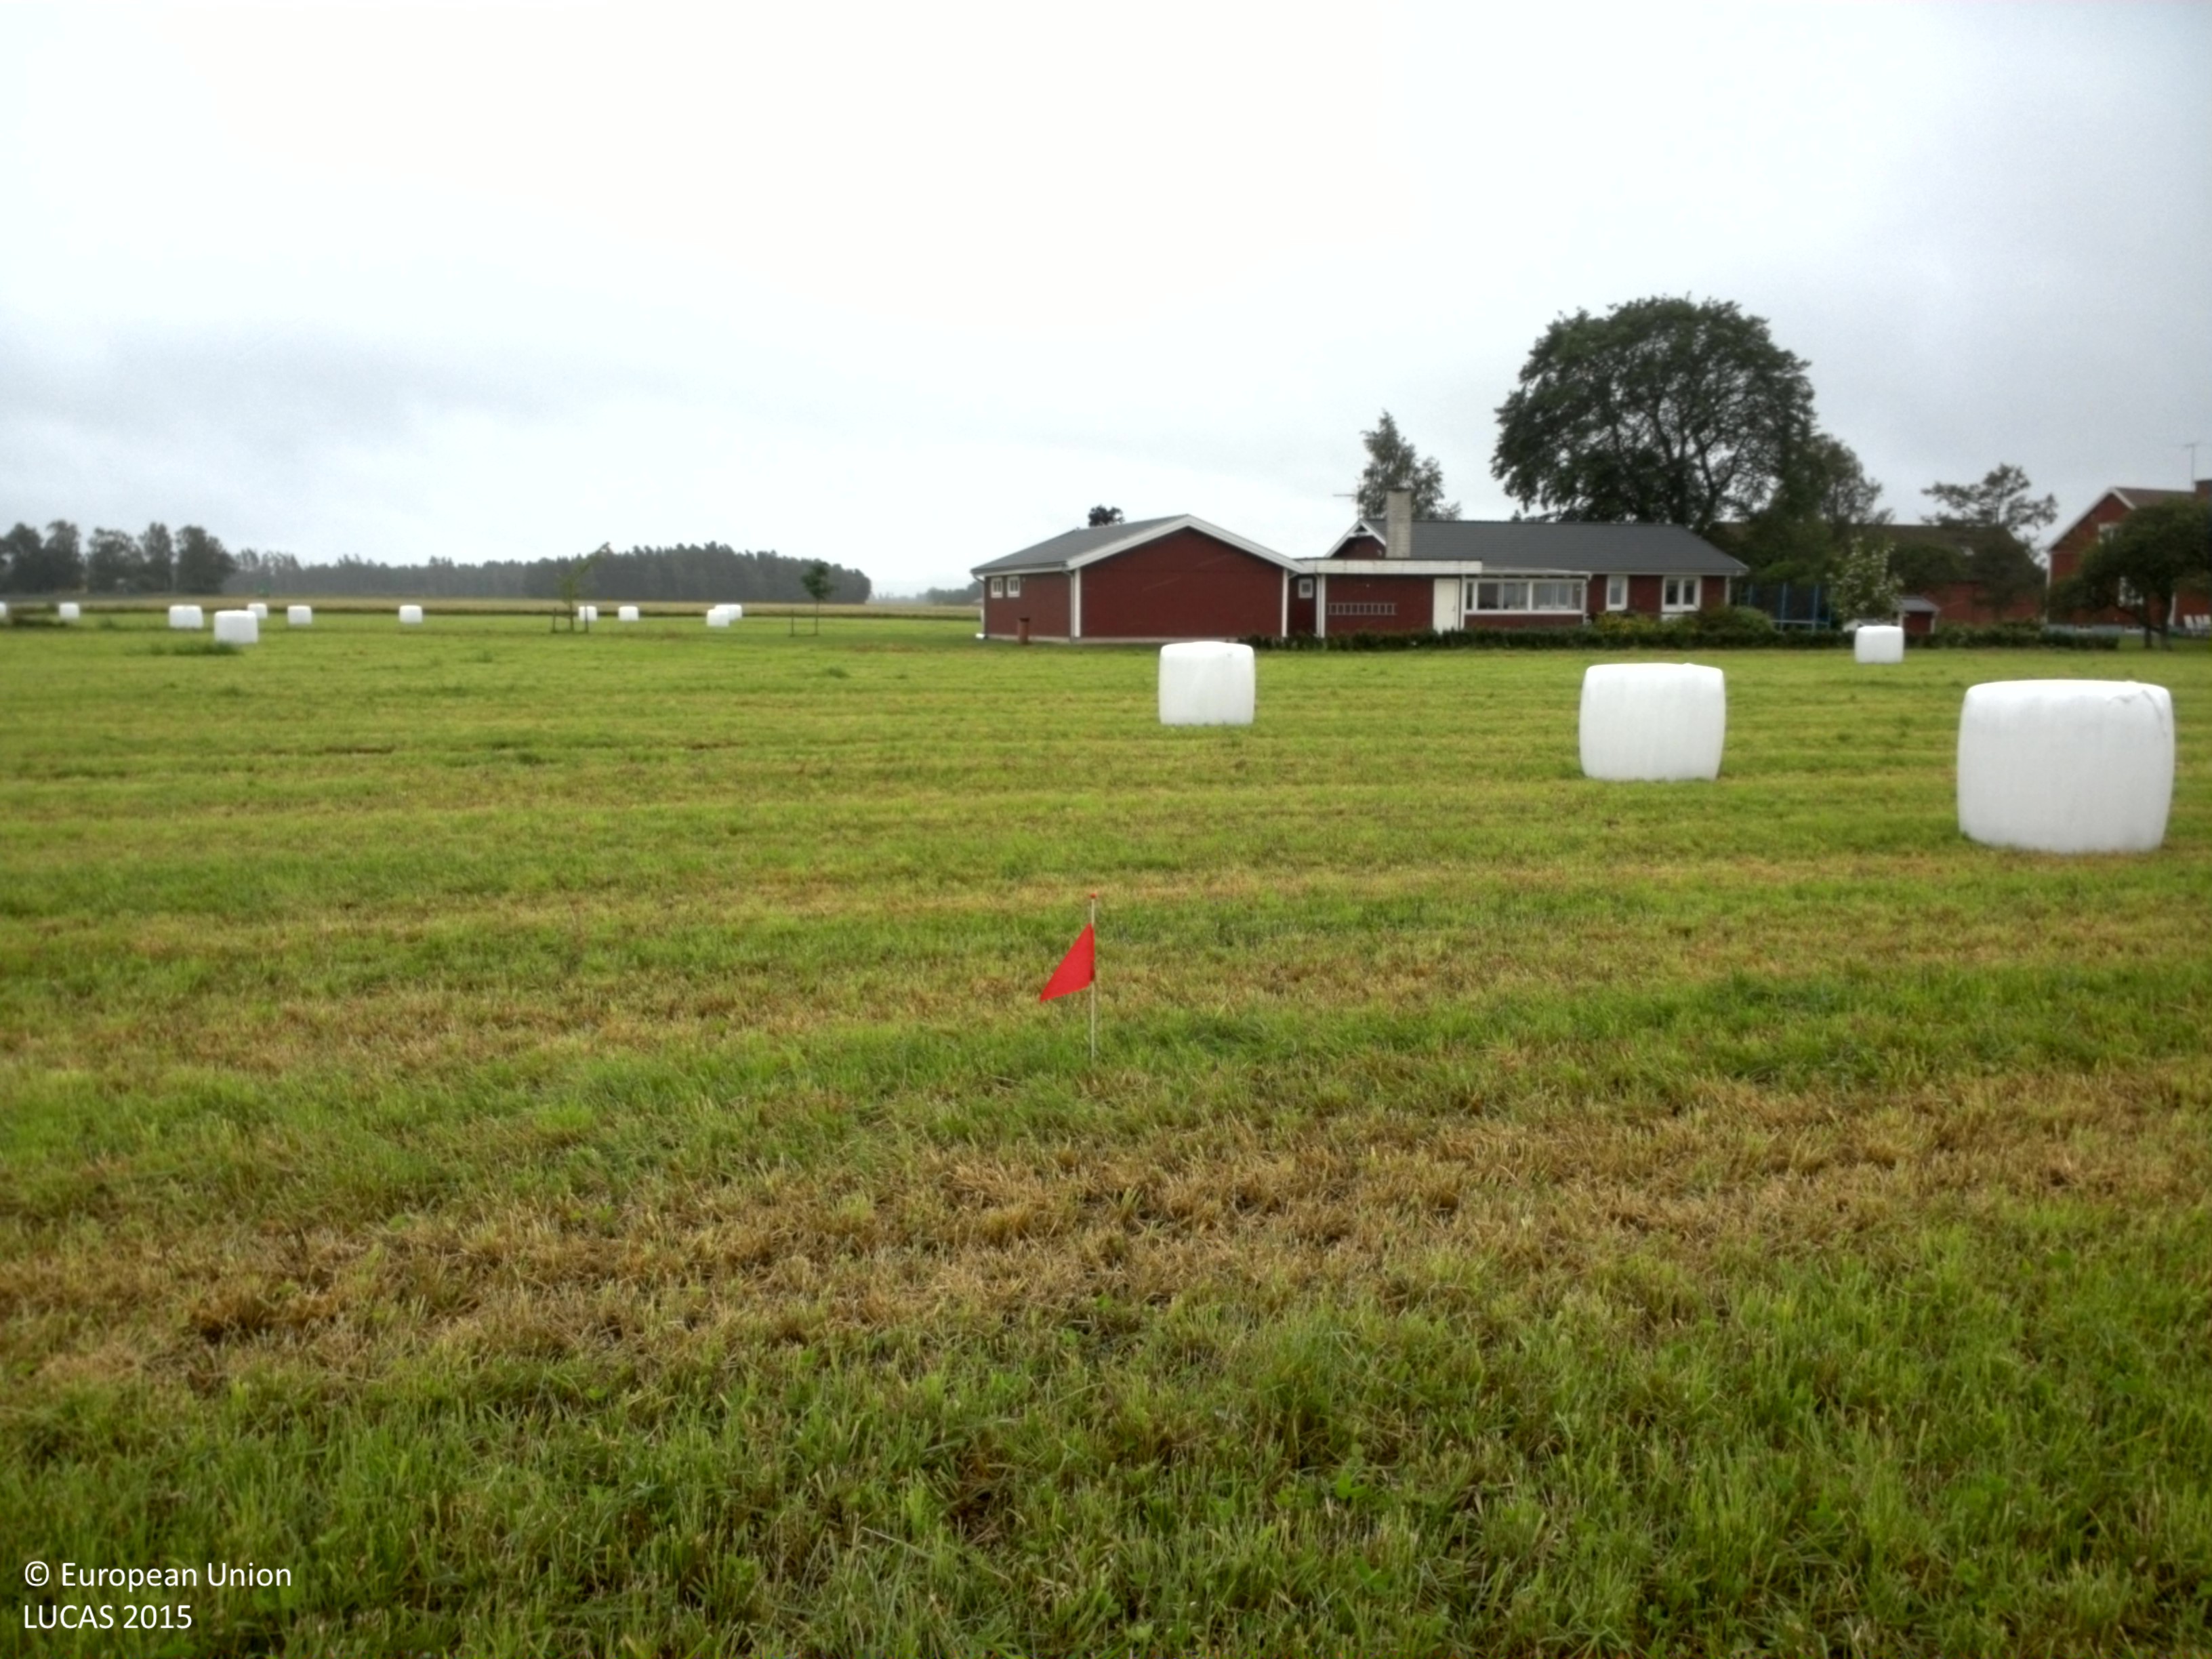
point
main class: Cropland
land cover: Other leguminous and mixtures for fodder
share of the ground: > 75 %
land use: Agriculture (excluding fallow land and kitchen gardens)
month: July
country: SE
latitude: 58.4653
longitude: 13.3711
